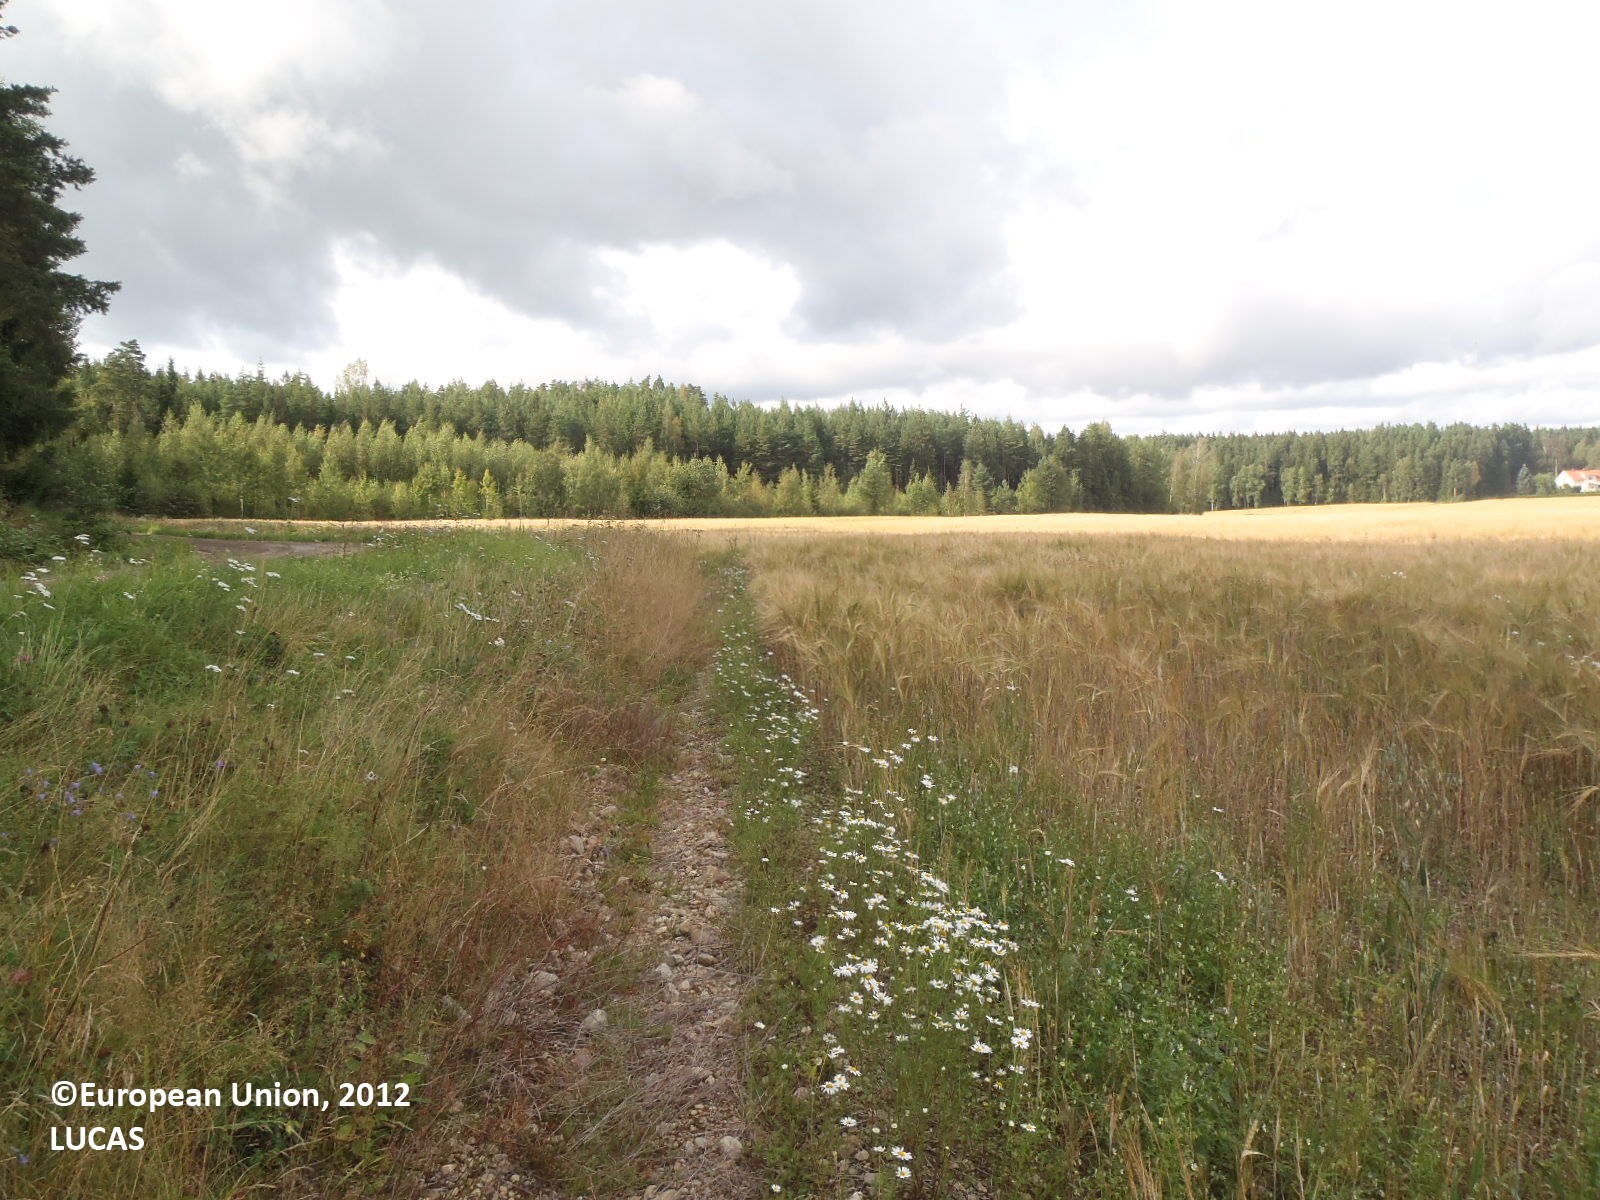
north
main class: Cropland
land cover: Mixed cereals for fodder
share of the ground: > 75 %
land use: Agriculture (excluding fallow land and kitchen gardens)
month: August
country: FI
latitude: 60.5031
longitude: 22.6538
